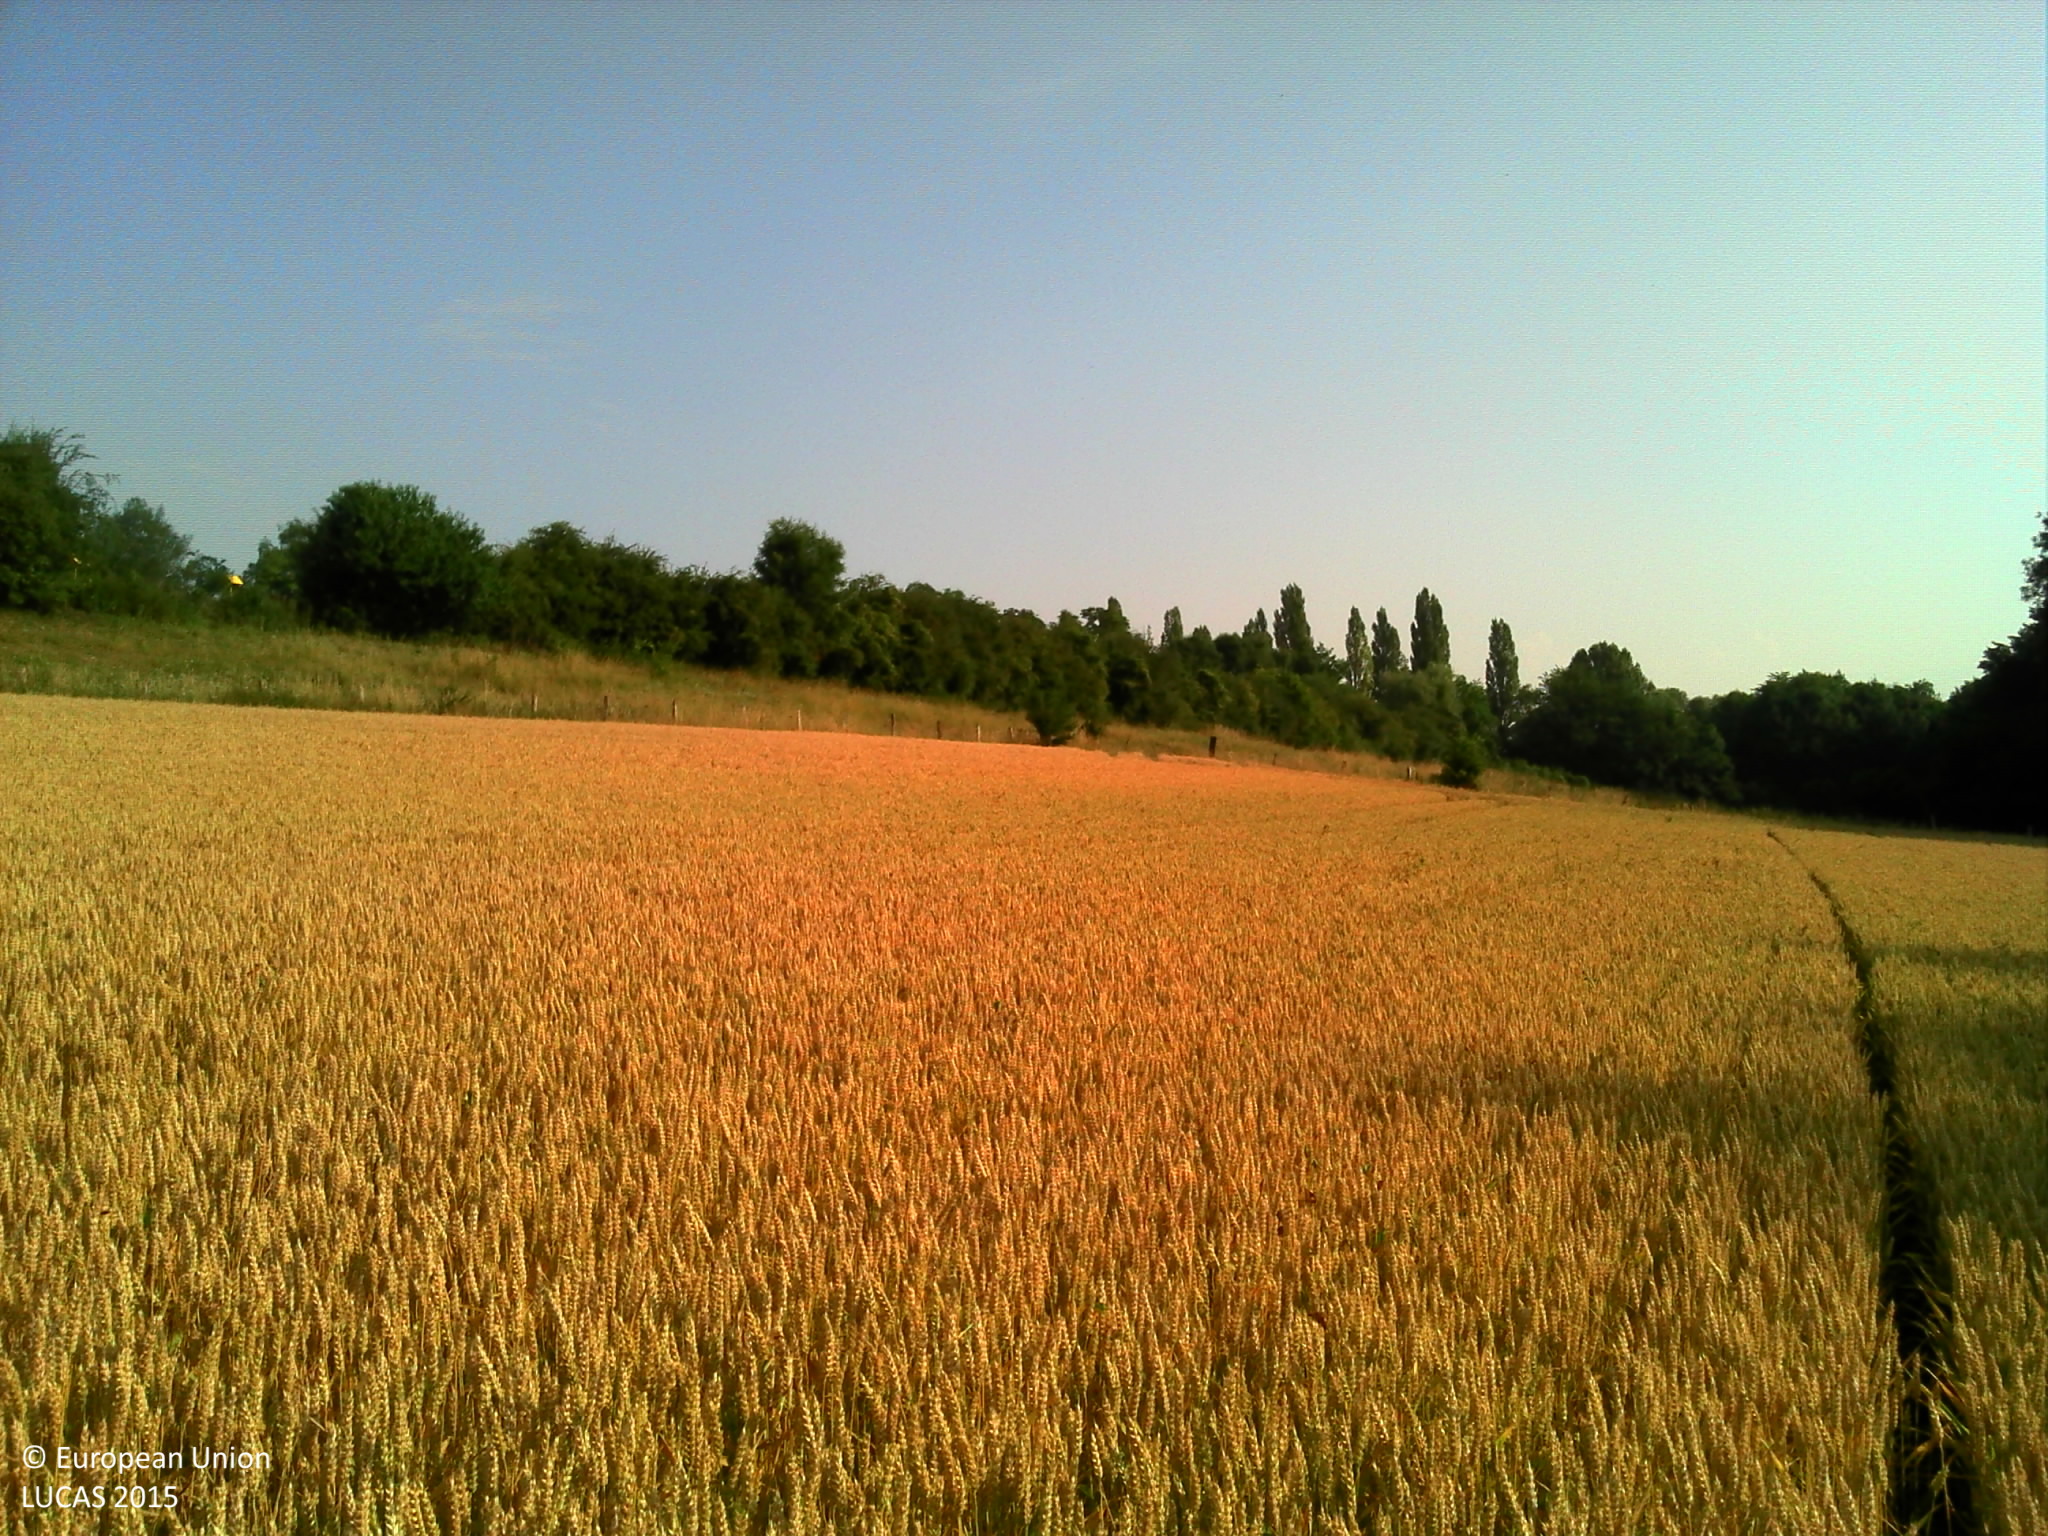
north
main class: Cropland
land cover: Common wheat
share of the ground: > 75 %
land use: Agriculture (excluding fallow land and kitchen gardens)
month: July
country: FR
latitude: 49.3080
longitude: 2.5475
